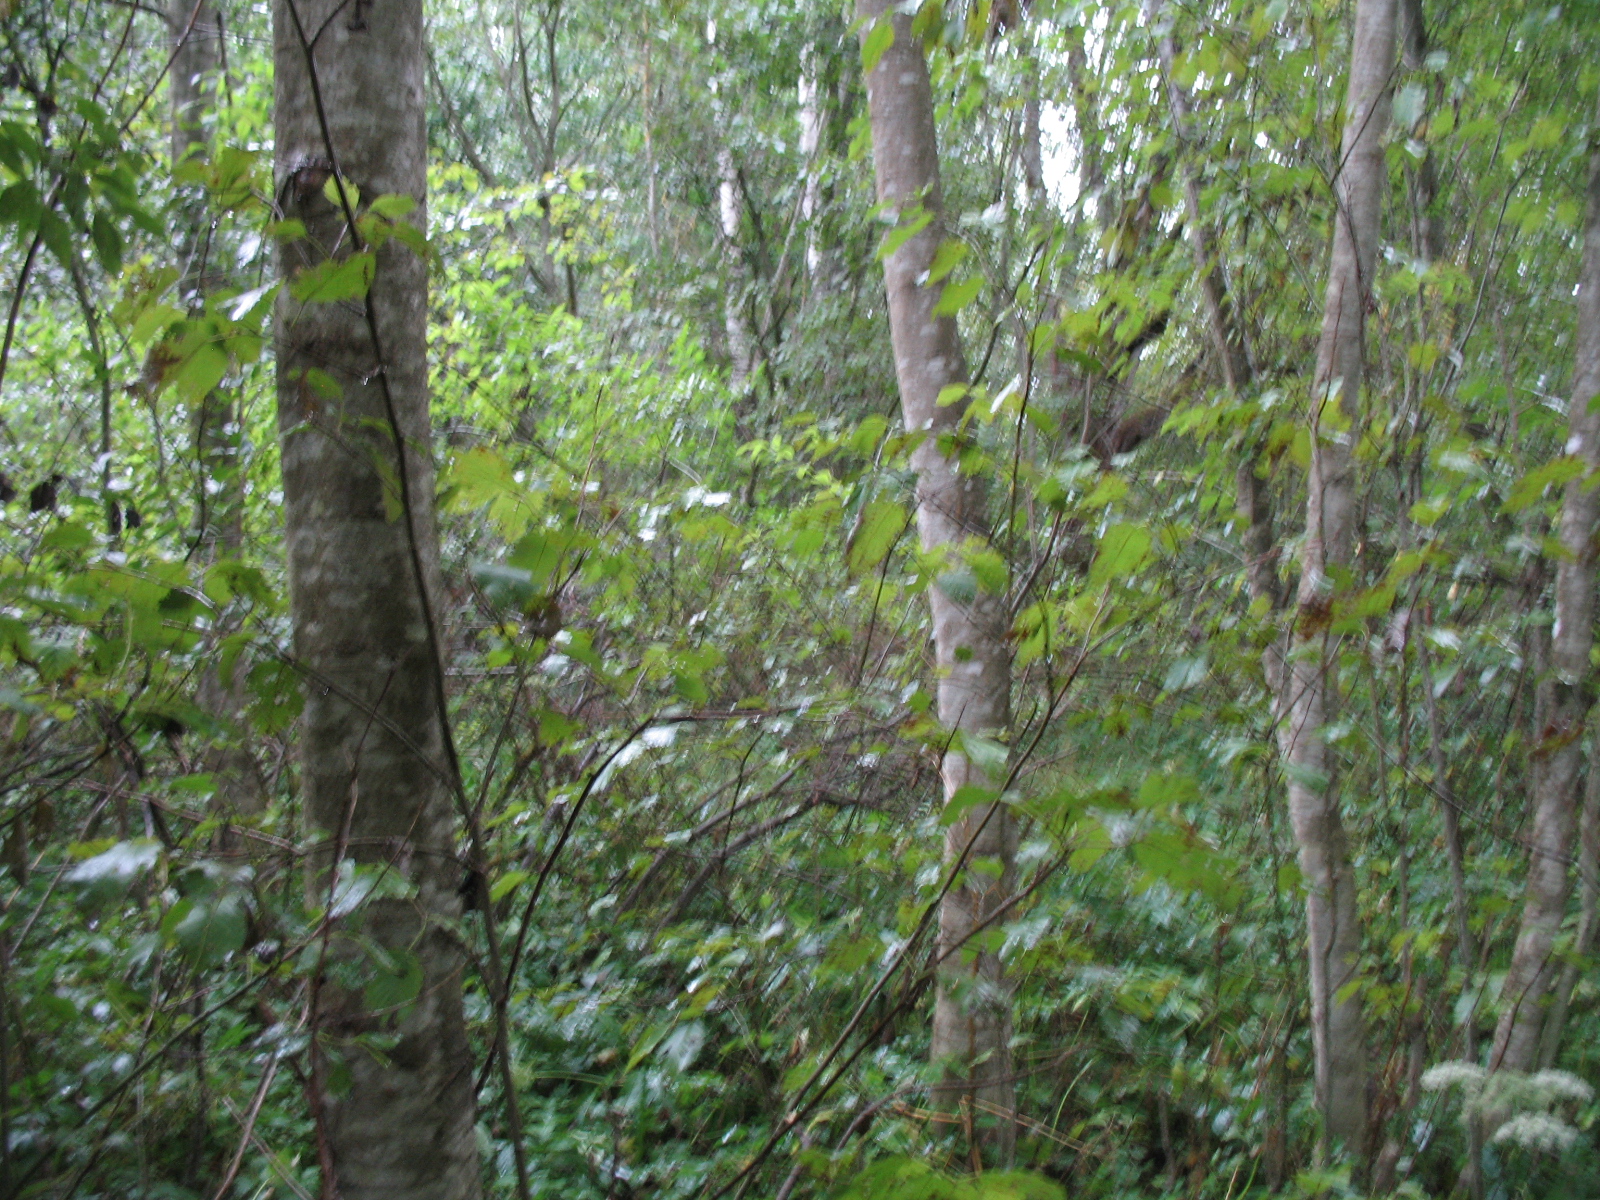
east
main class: Woodland
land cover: Broadleaved woodland
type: non-riverine alder, birch or aspen forest
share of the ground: > 75 %
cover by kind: broadleaved forest trees 80 %, shrubs 15 %, herbaceous plants 5 %
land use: Forestry
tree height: > 5 m
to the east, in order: Broadleaved woodland; Grassland without tree/shrub cover
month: August
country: LV
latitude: 56.2833
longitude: 25.9471
